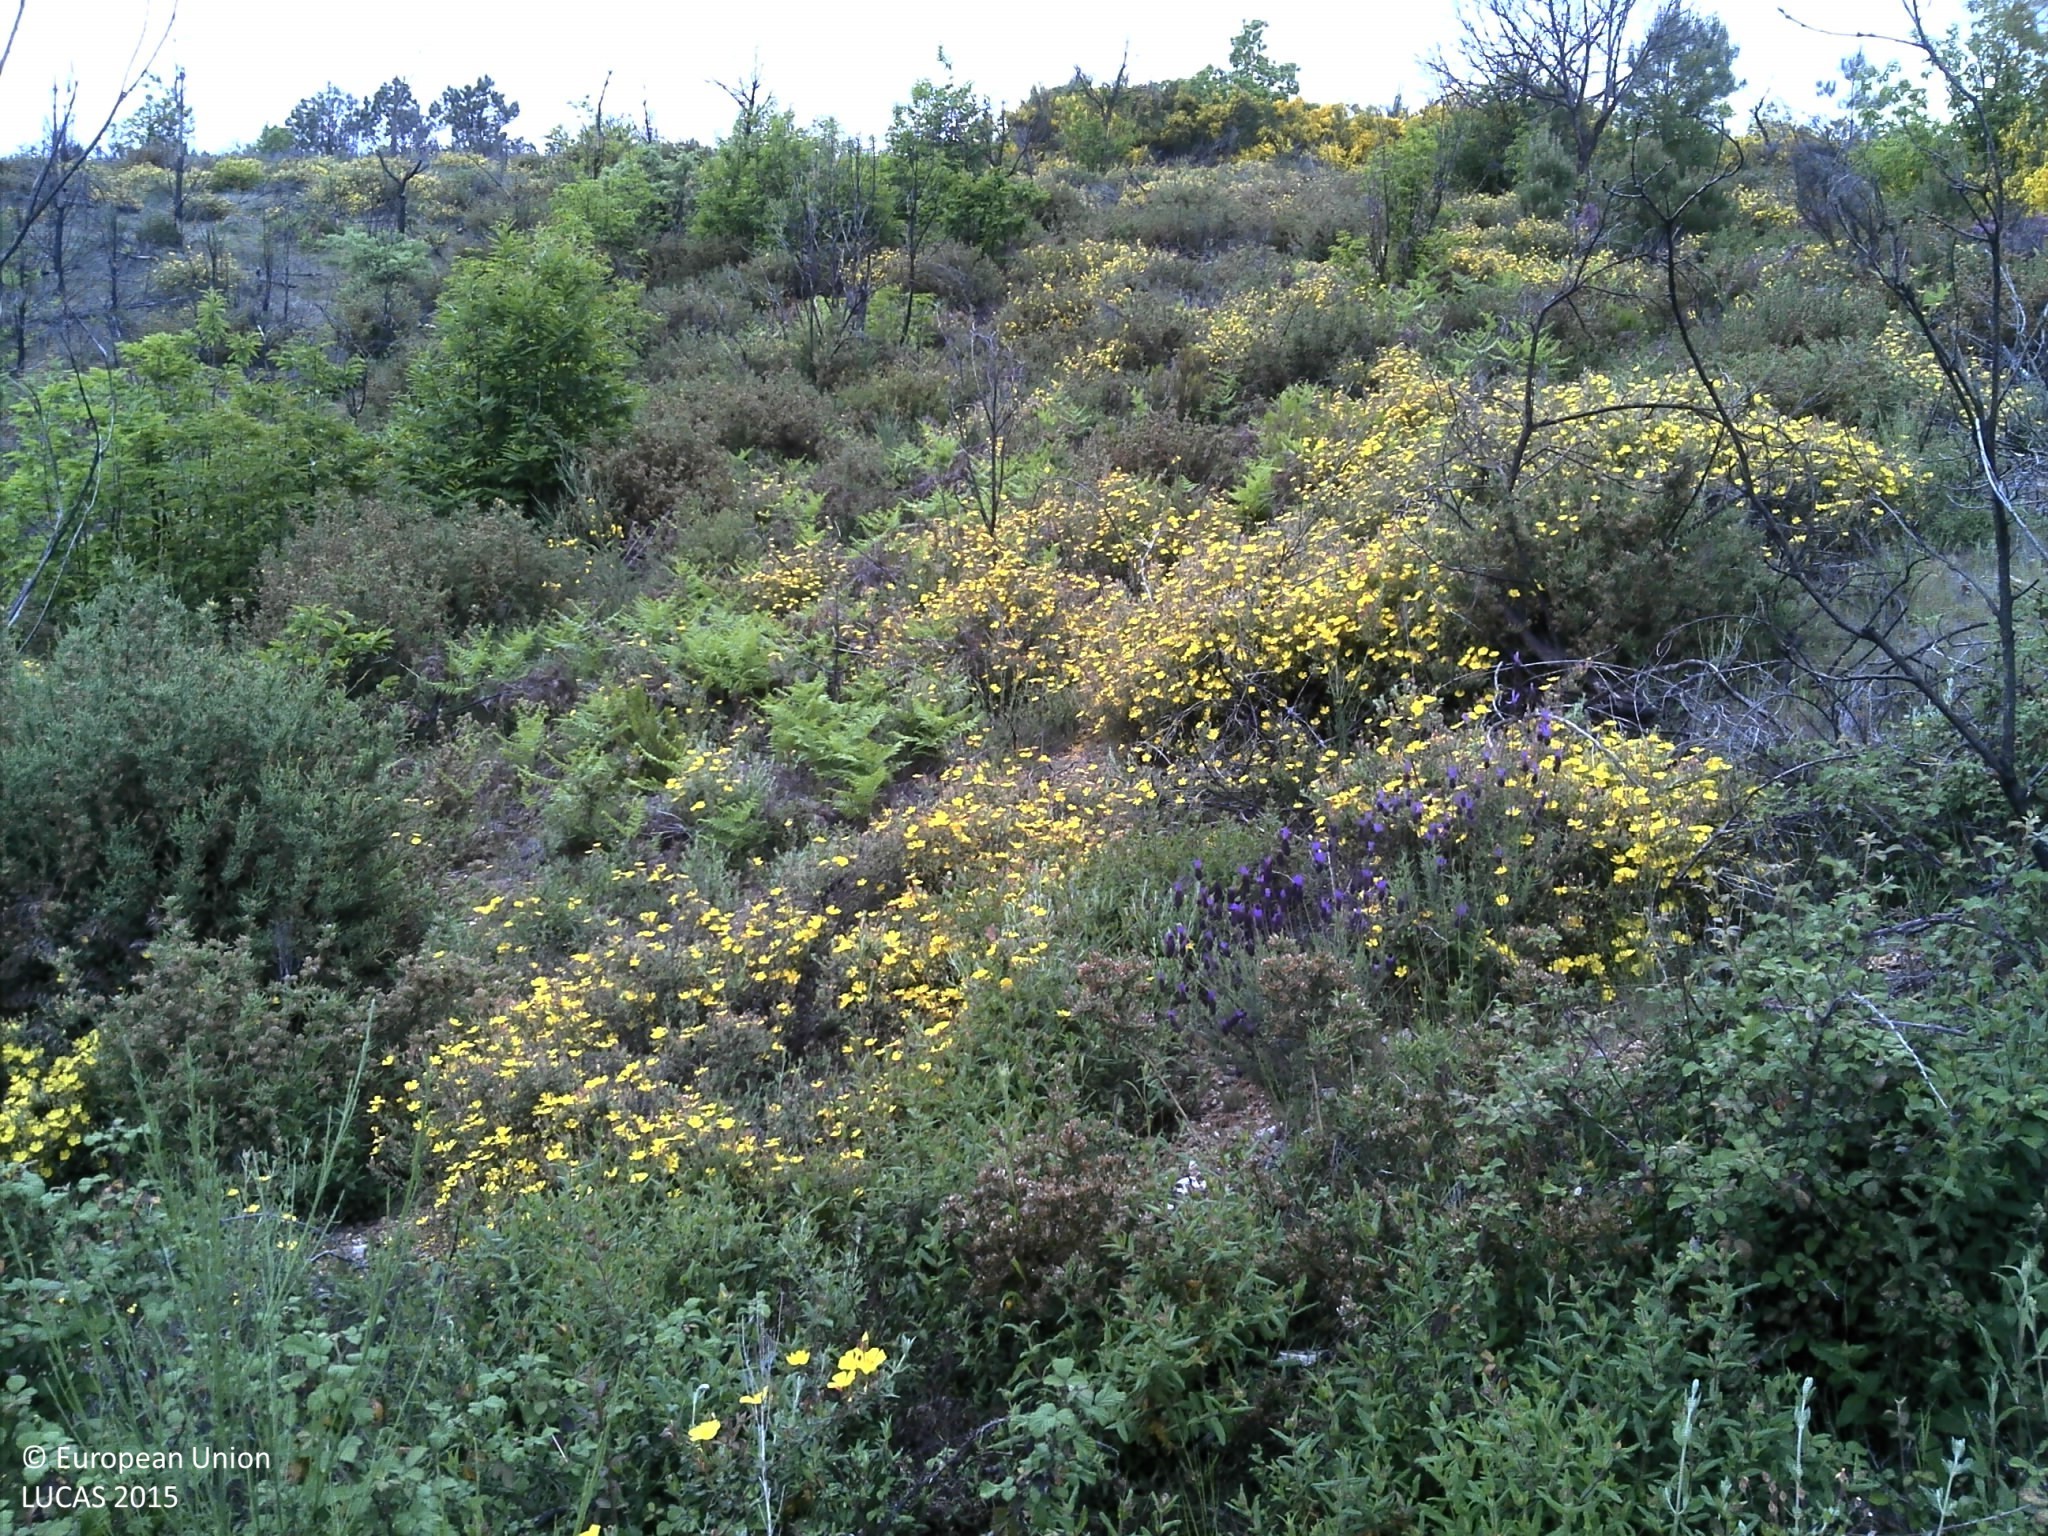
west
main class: Shrubland
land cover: Shrubland with sparse tree cover
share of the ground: 25 - 50 %
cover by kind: shrubs 50 %, unconsolidated bare surface 40 %, broadleaved forest trees 5 %, herbaceous plants 5 %
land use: Forestry
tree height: < 5 m
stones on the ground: 10 - 25 %
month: May
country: PT
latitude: 41.7947
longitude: -7.1017
